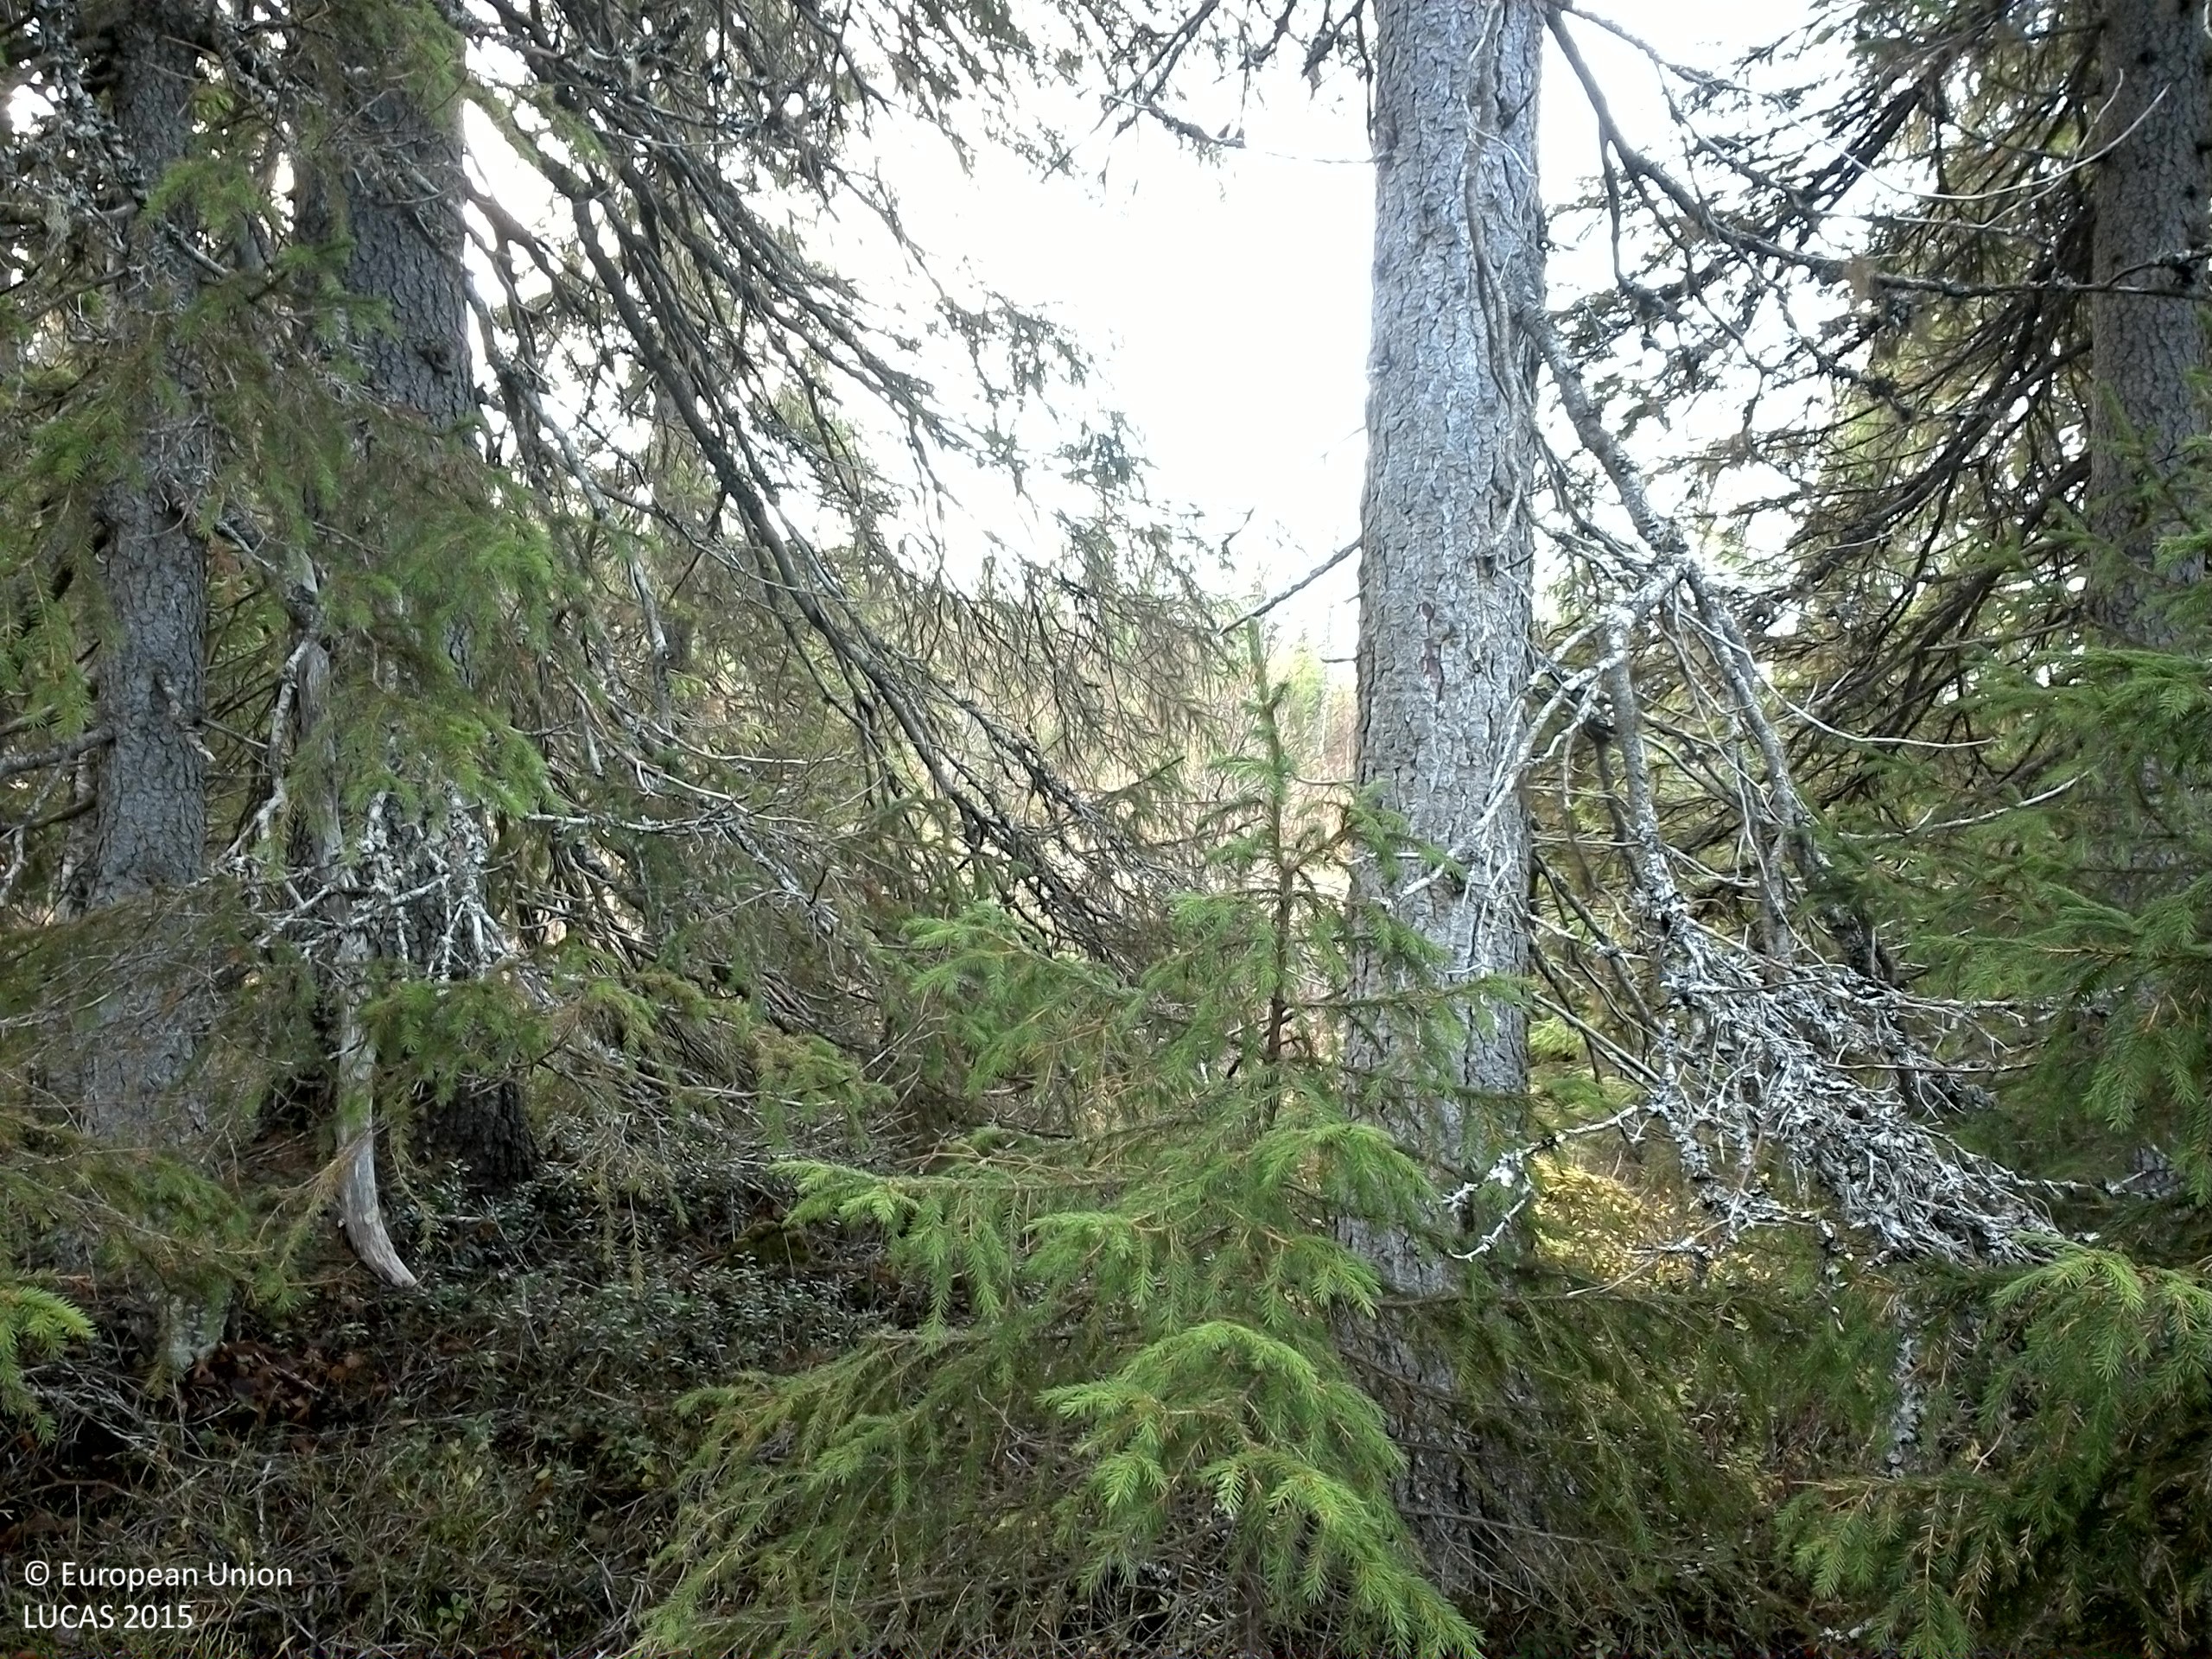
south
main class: Woodland
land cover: Spruce dominated coniferous woodland
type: boreal forest
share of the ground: 25 - 50 %
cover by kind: coniferous forest trees 40 %, shrubs 40 %, lichens and mosses 15 %, broadleaved forest trees 5 %
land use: Forestry
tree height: > 5 m
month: October
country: SE
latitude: 64.6196
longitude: 13.9694
